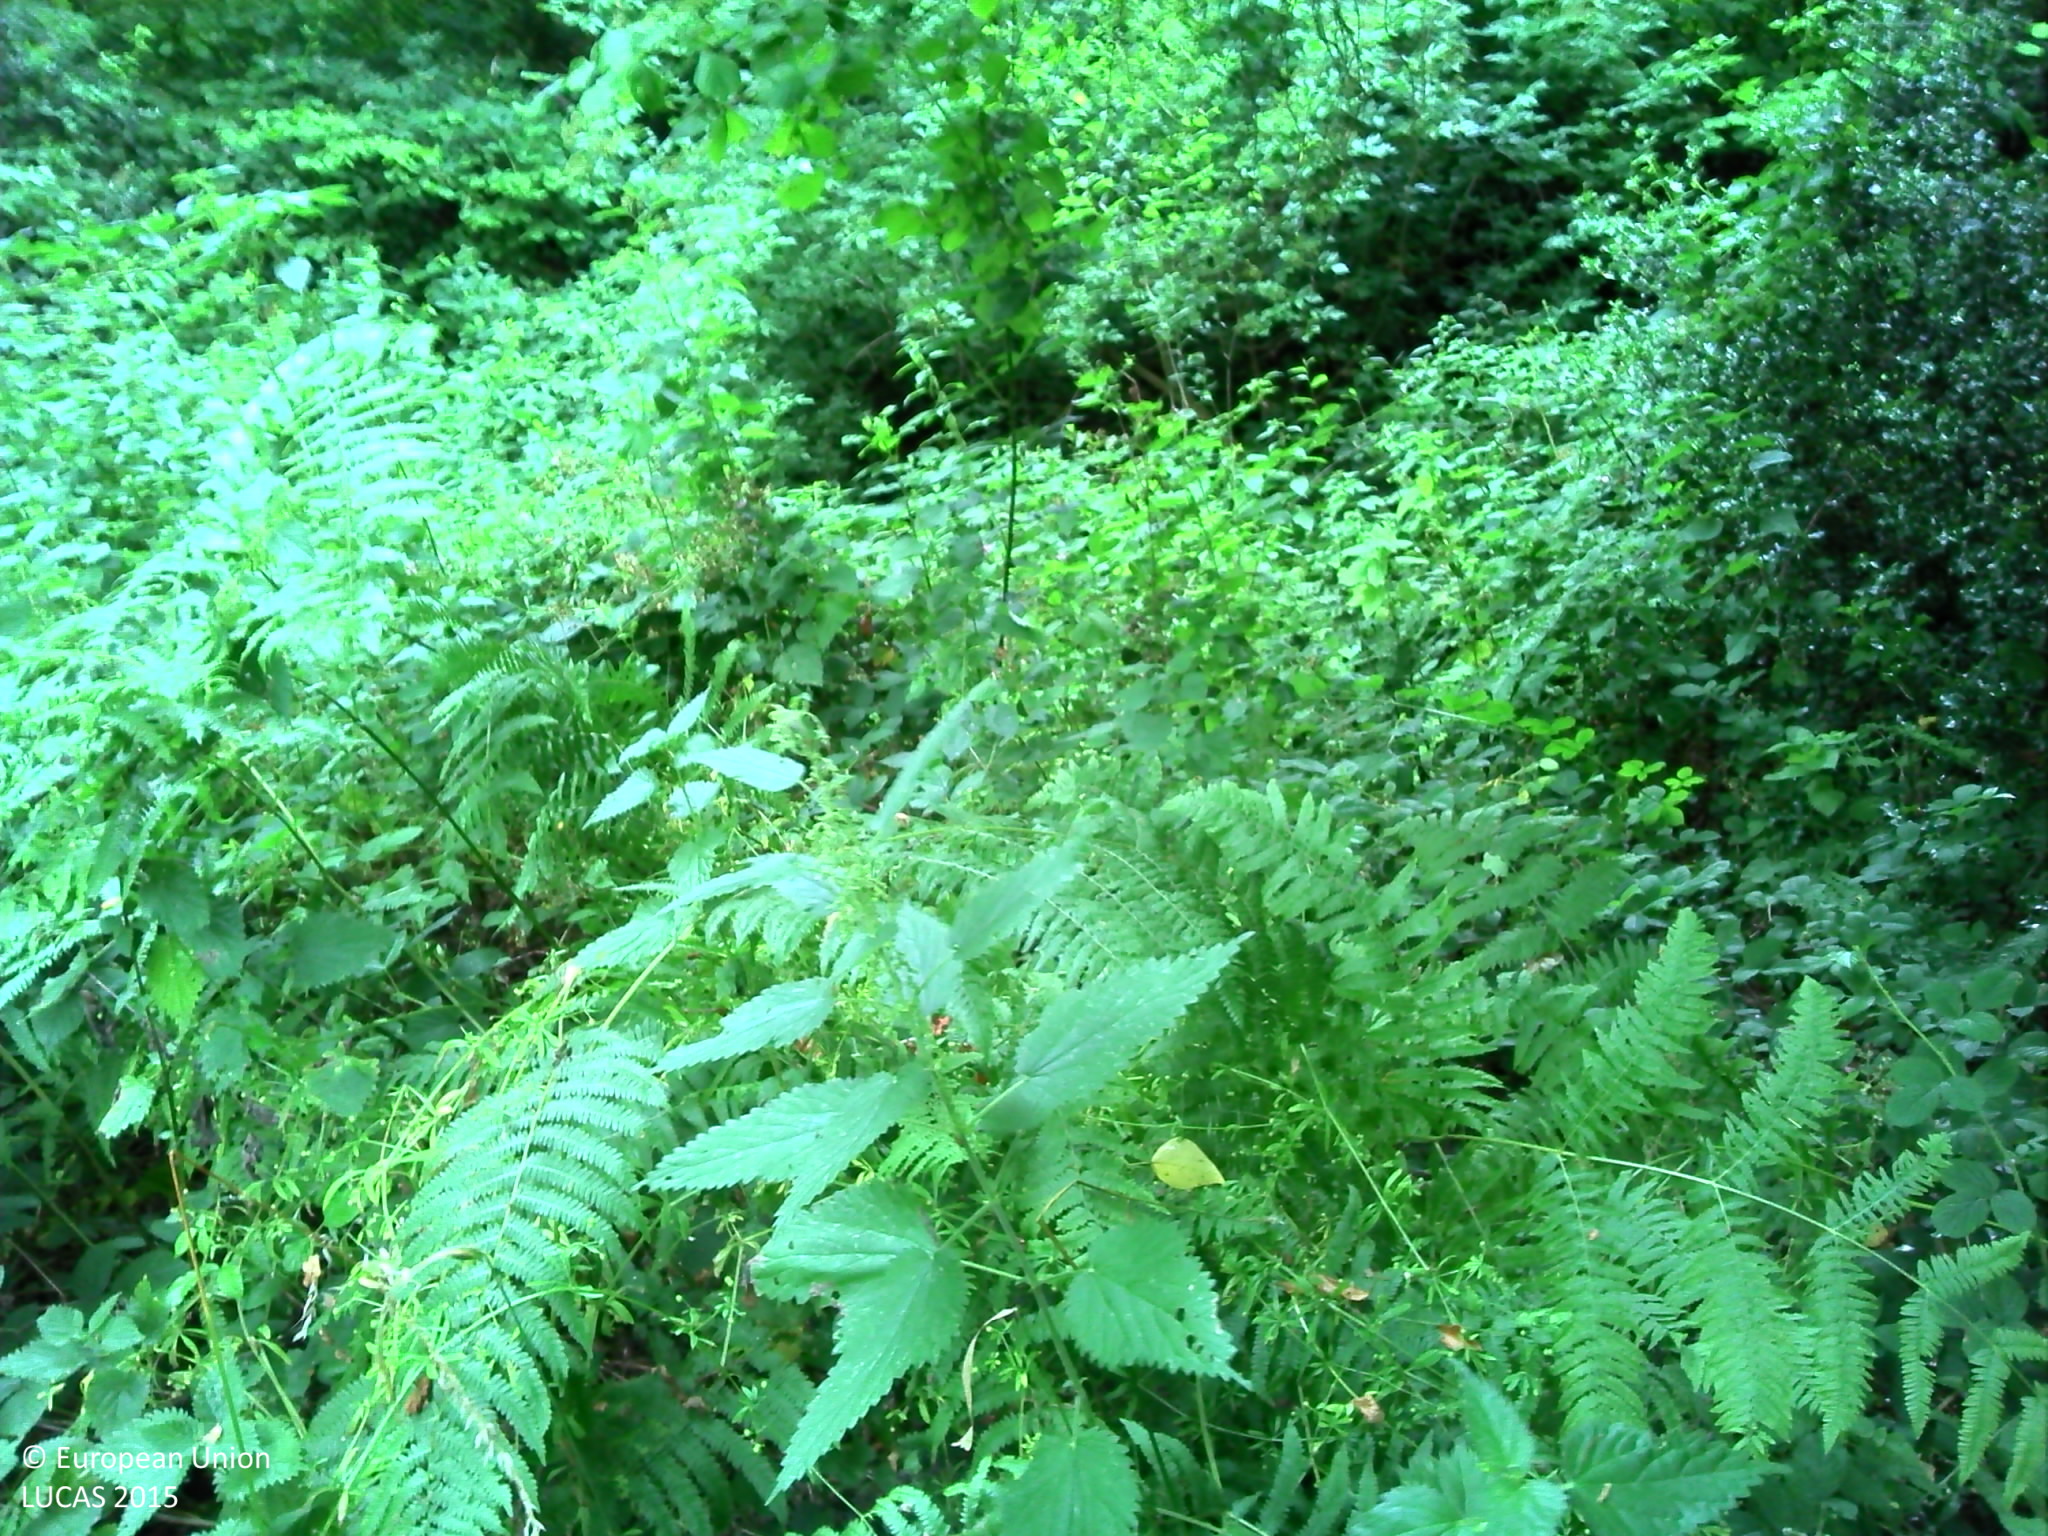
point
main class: Woodland
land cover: Broadleaved woodland
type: mesophytic deciduous forest
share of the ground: > 75 %
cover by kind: broadleaved forest trees 65 %, herbaceous plants 20 %, consolidated bare surface 10 %, lichens and mosses 5 %
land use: Forestry
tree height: > 5 m
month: July
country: FR
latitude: 47.8731
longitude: -3.2678
